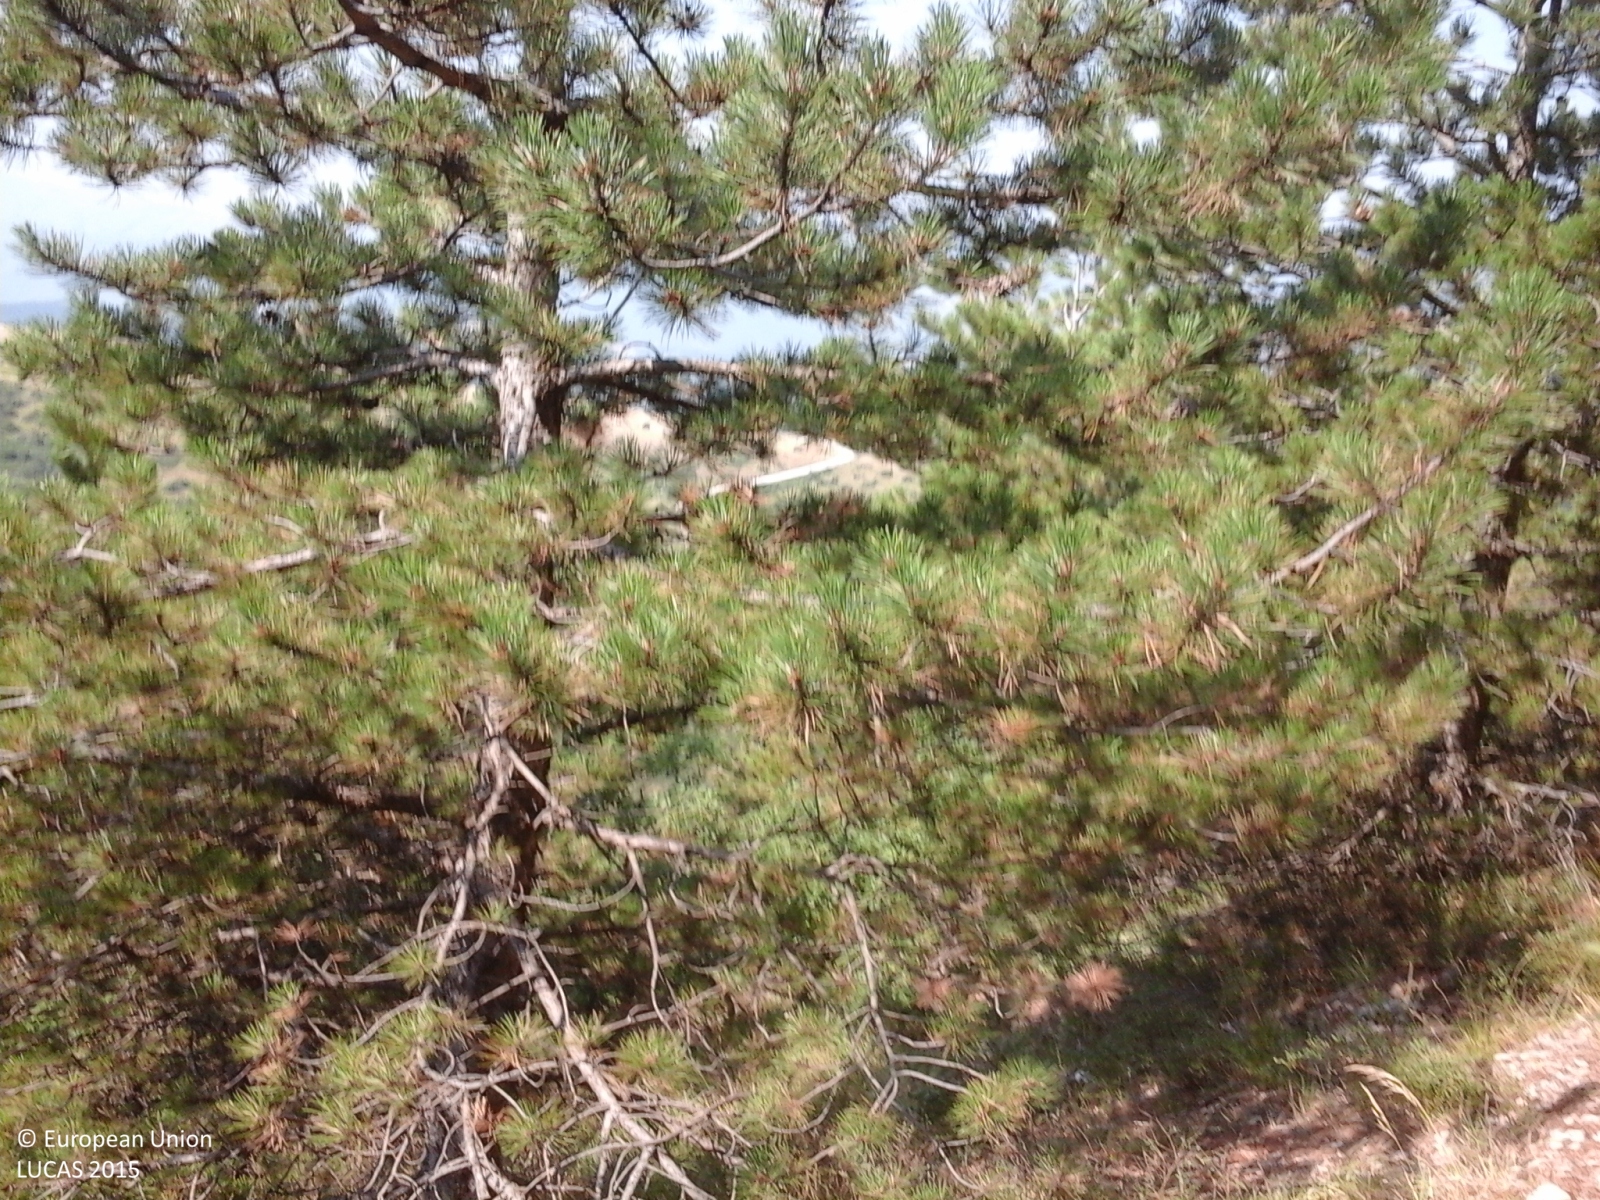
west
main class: Woodland
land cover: Other mixed woodland
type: thermophilous deciduous forest
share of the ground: > 75 %
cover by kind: broadleaved forest trees 75 %, coniferous forest trees 25 %
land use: Forestry
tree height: < 5 m
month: August
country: IT
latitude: 43.0216
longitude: 13.1203
